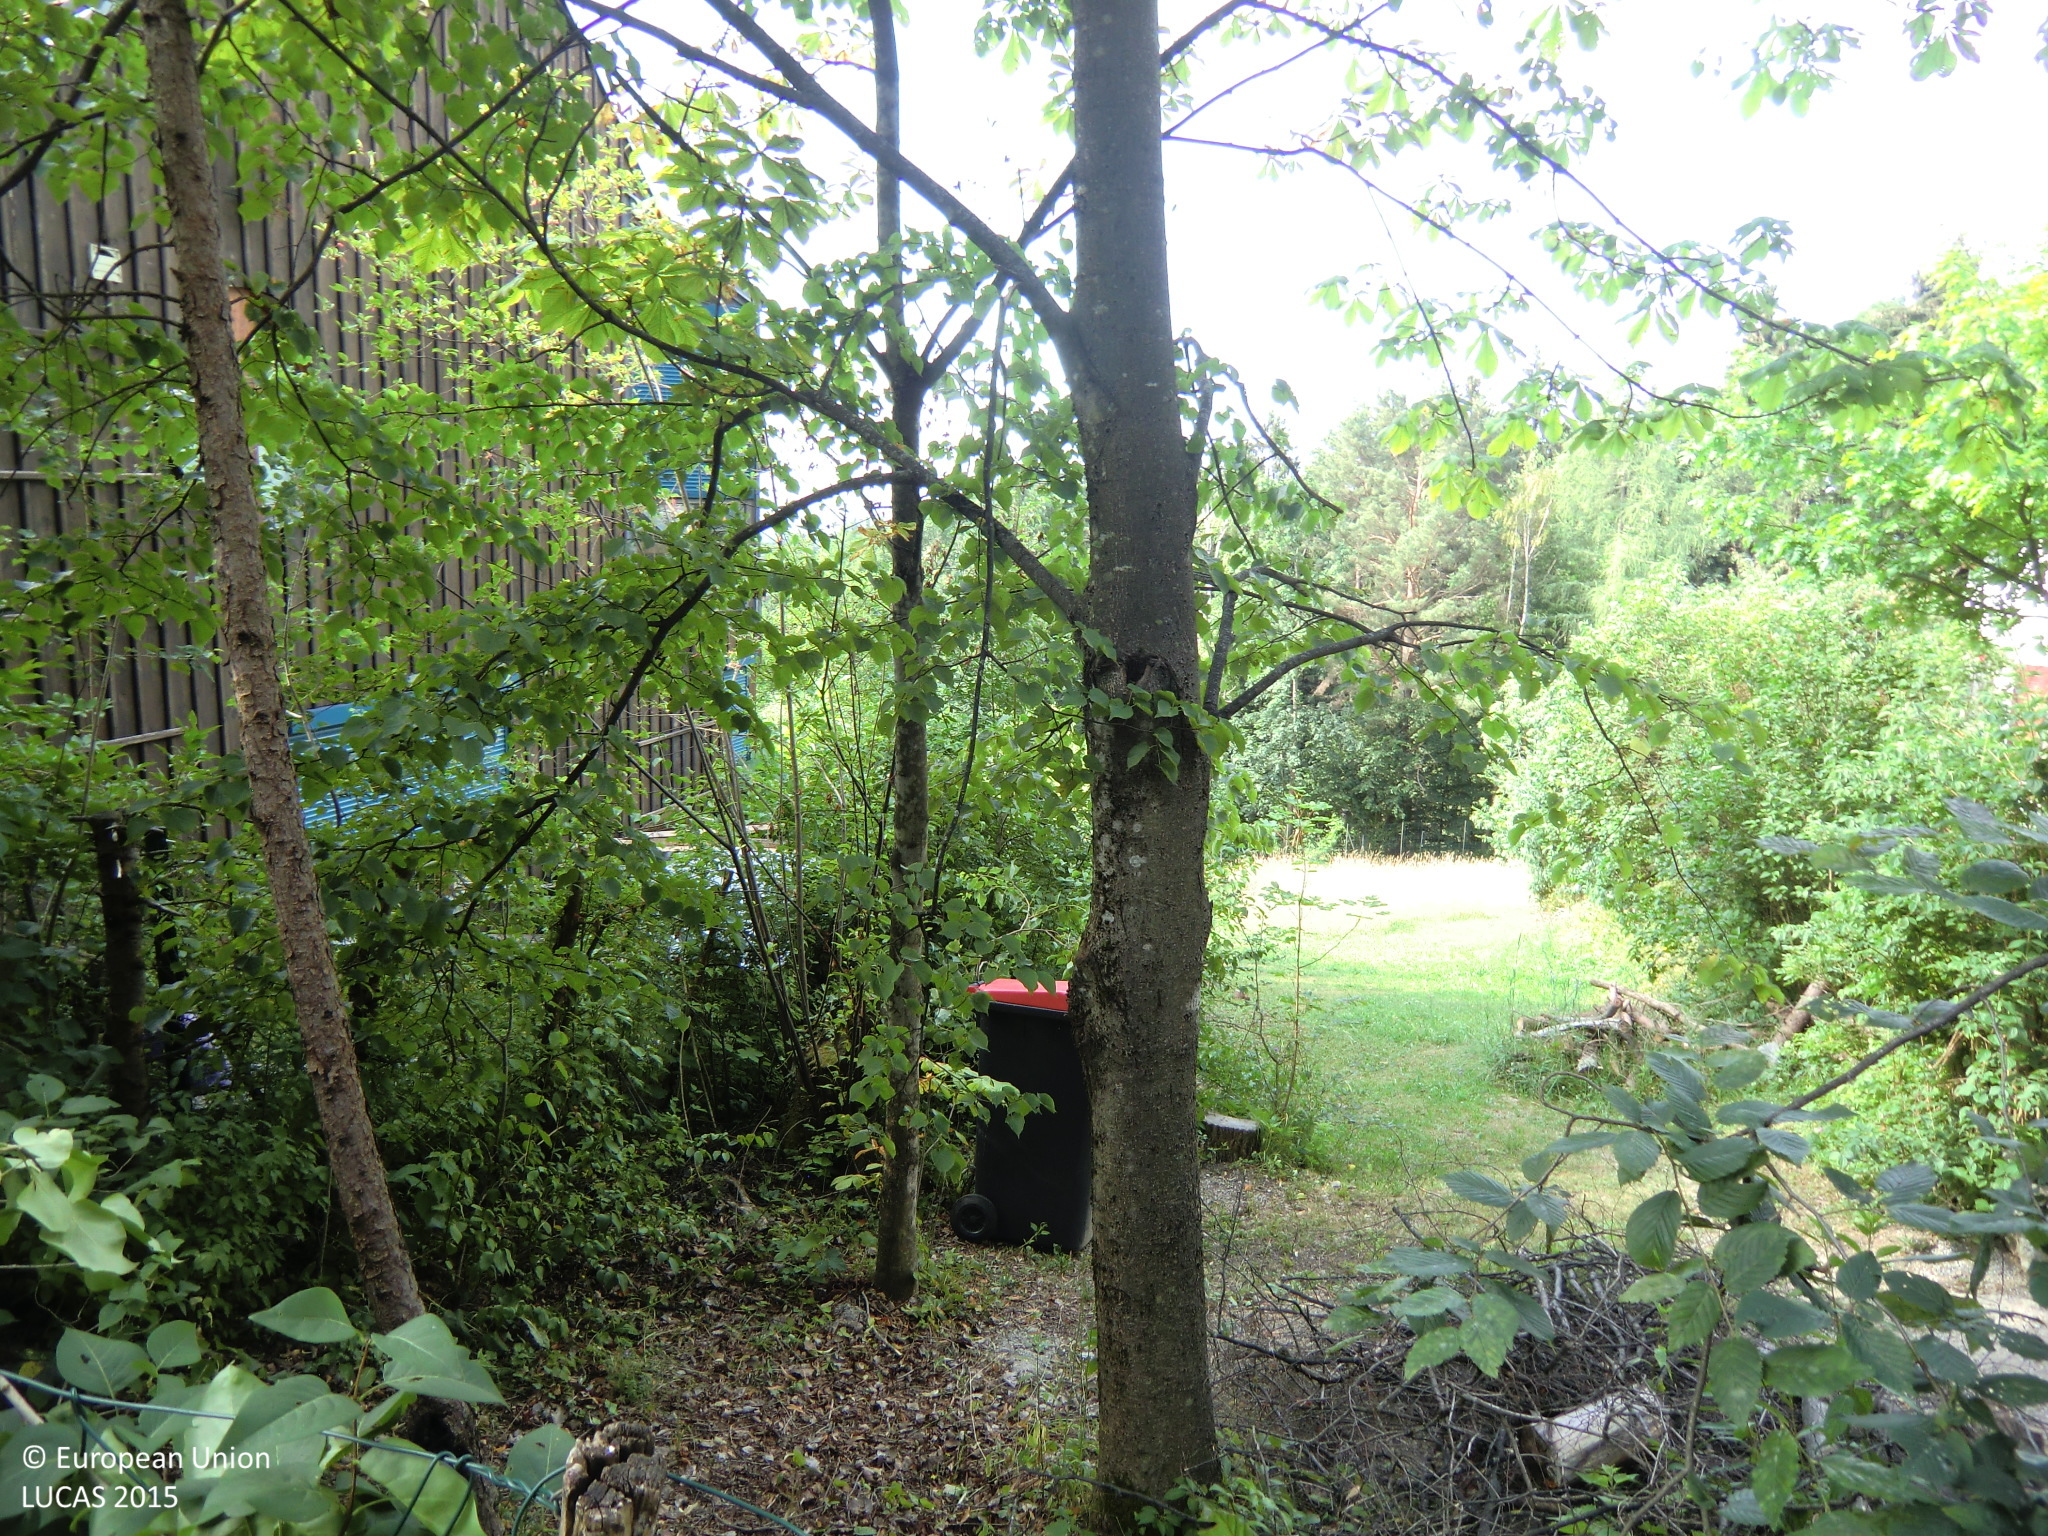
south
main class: Woodland
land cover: Other mixed woodland
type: hemiboreal forest and nemoral coniferous forest and mixed broadleaved-coniferous forest
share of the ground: > 75 %
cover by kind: coniferous forest trees 45 %, broadleaved forest trees 45 %, unconsolidated bare surface 10 %
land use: Forestry
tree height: > 5 m
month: July
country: AT
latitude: 47.1509
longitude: 15.4468
